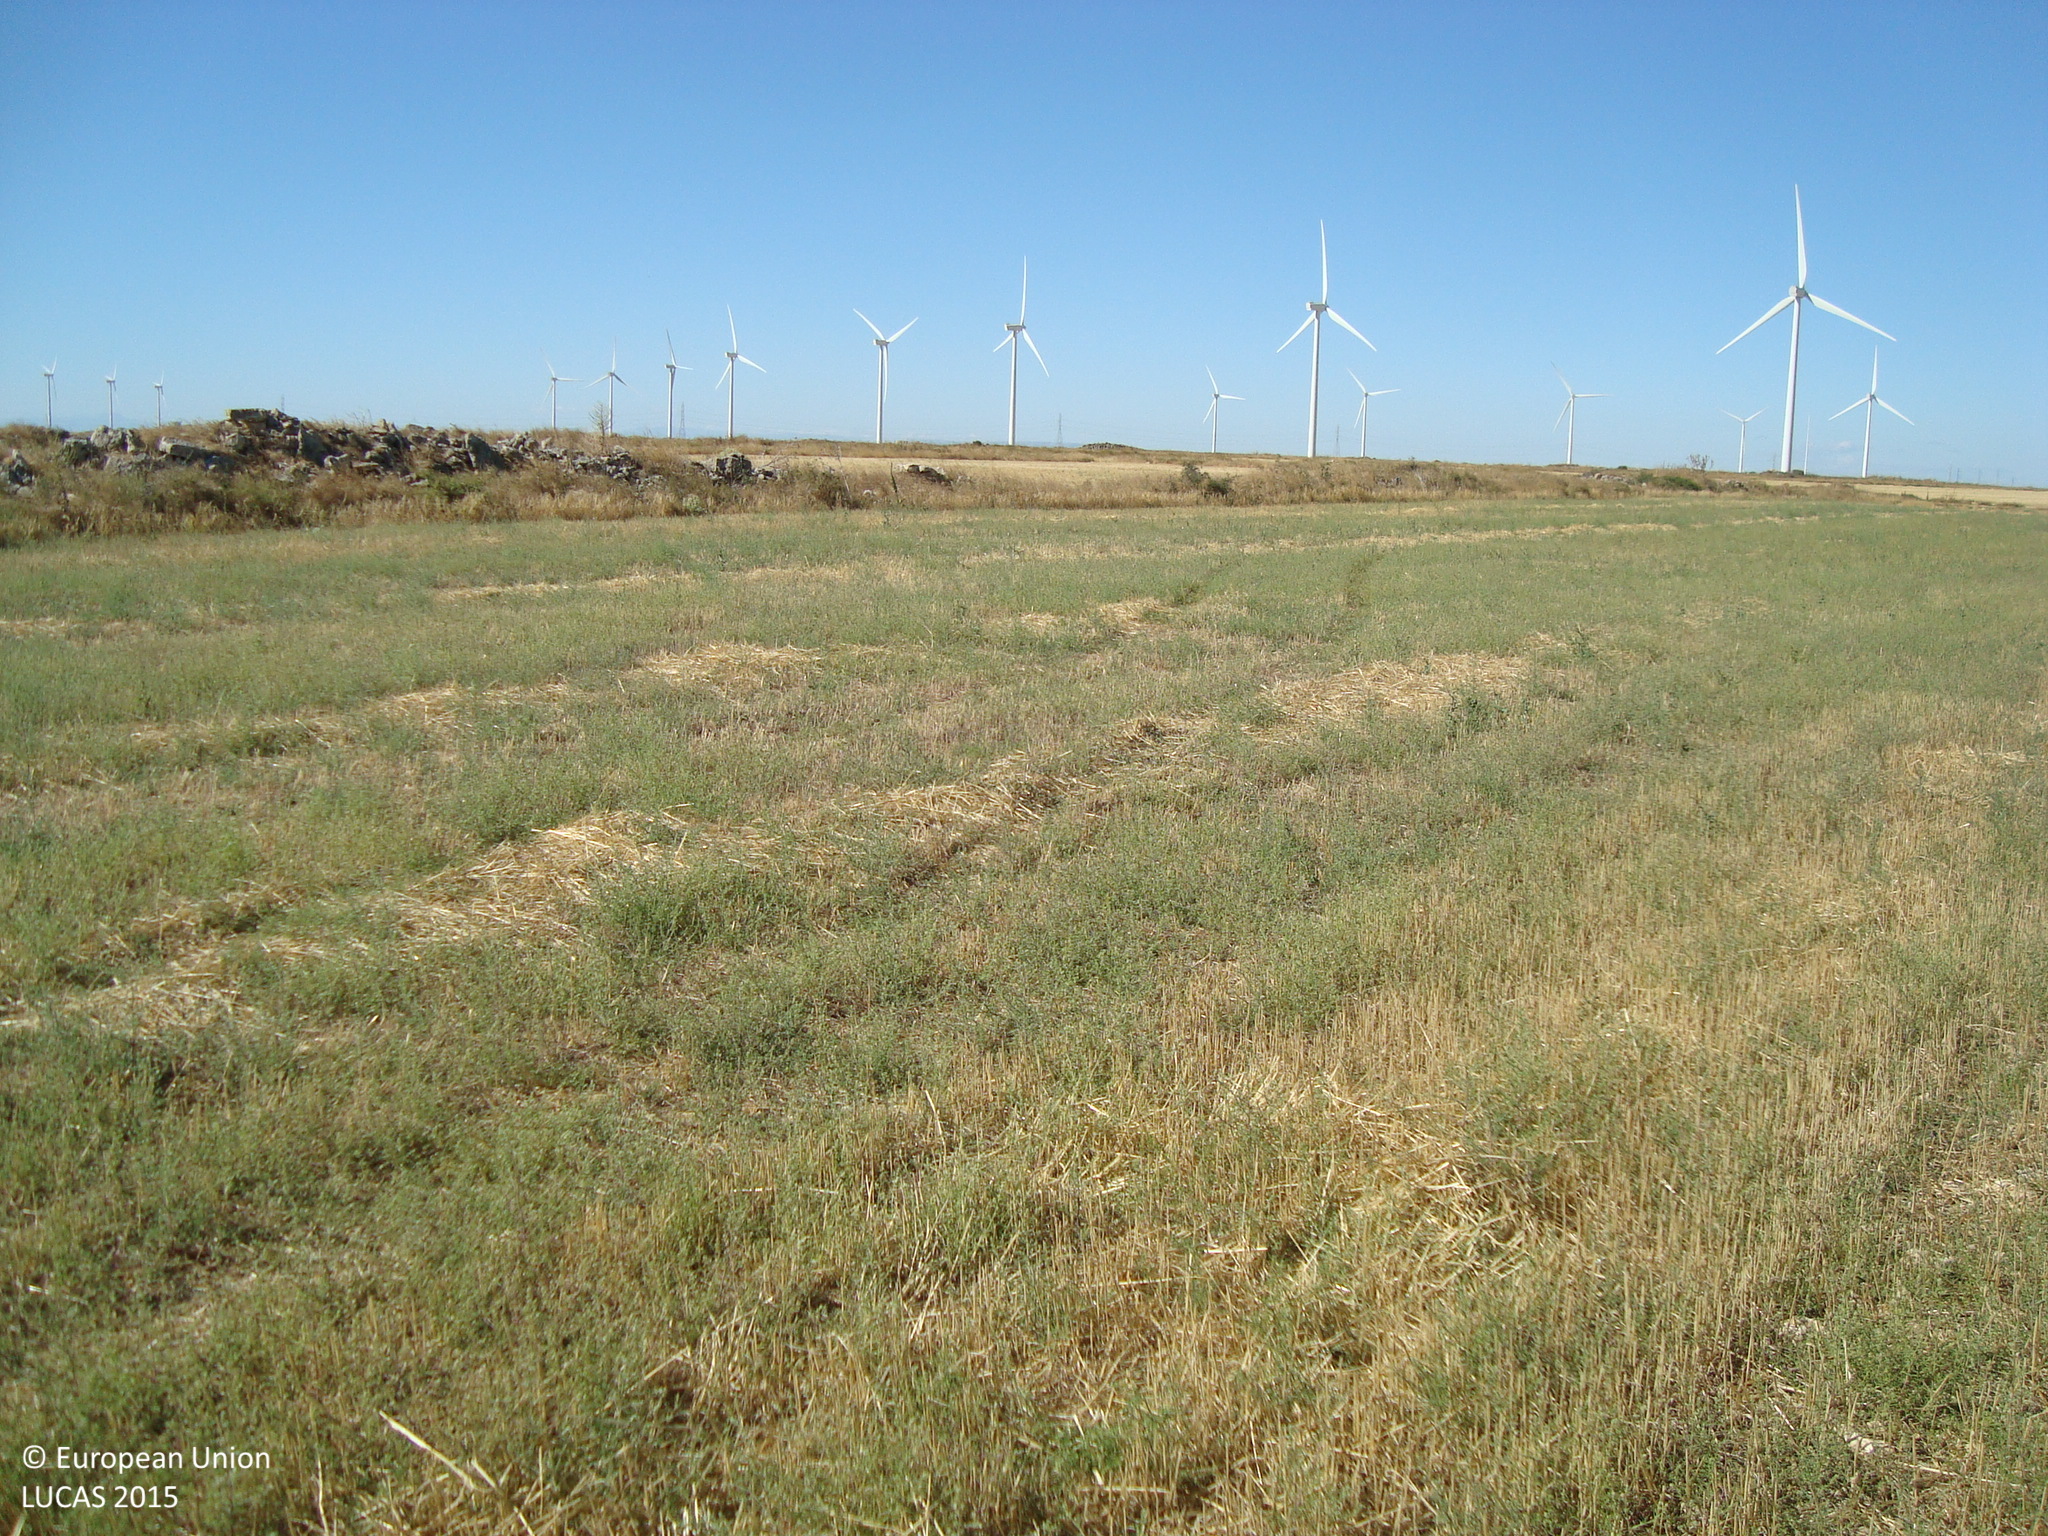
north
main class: Cropland
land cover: Barley
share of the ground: > 75 %
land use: Agriculture (excluding fallow land and kitchen gardens)
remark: Harvested field
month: August
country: ES
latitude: 42.2216
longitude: -4.1560
